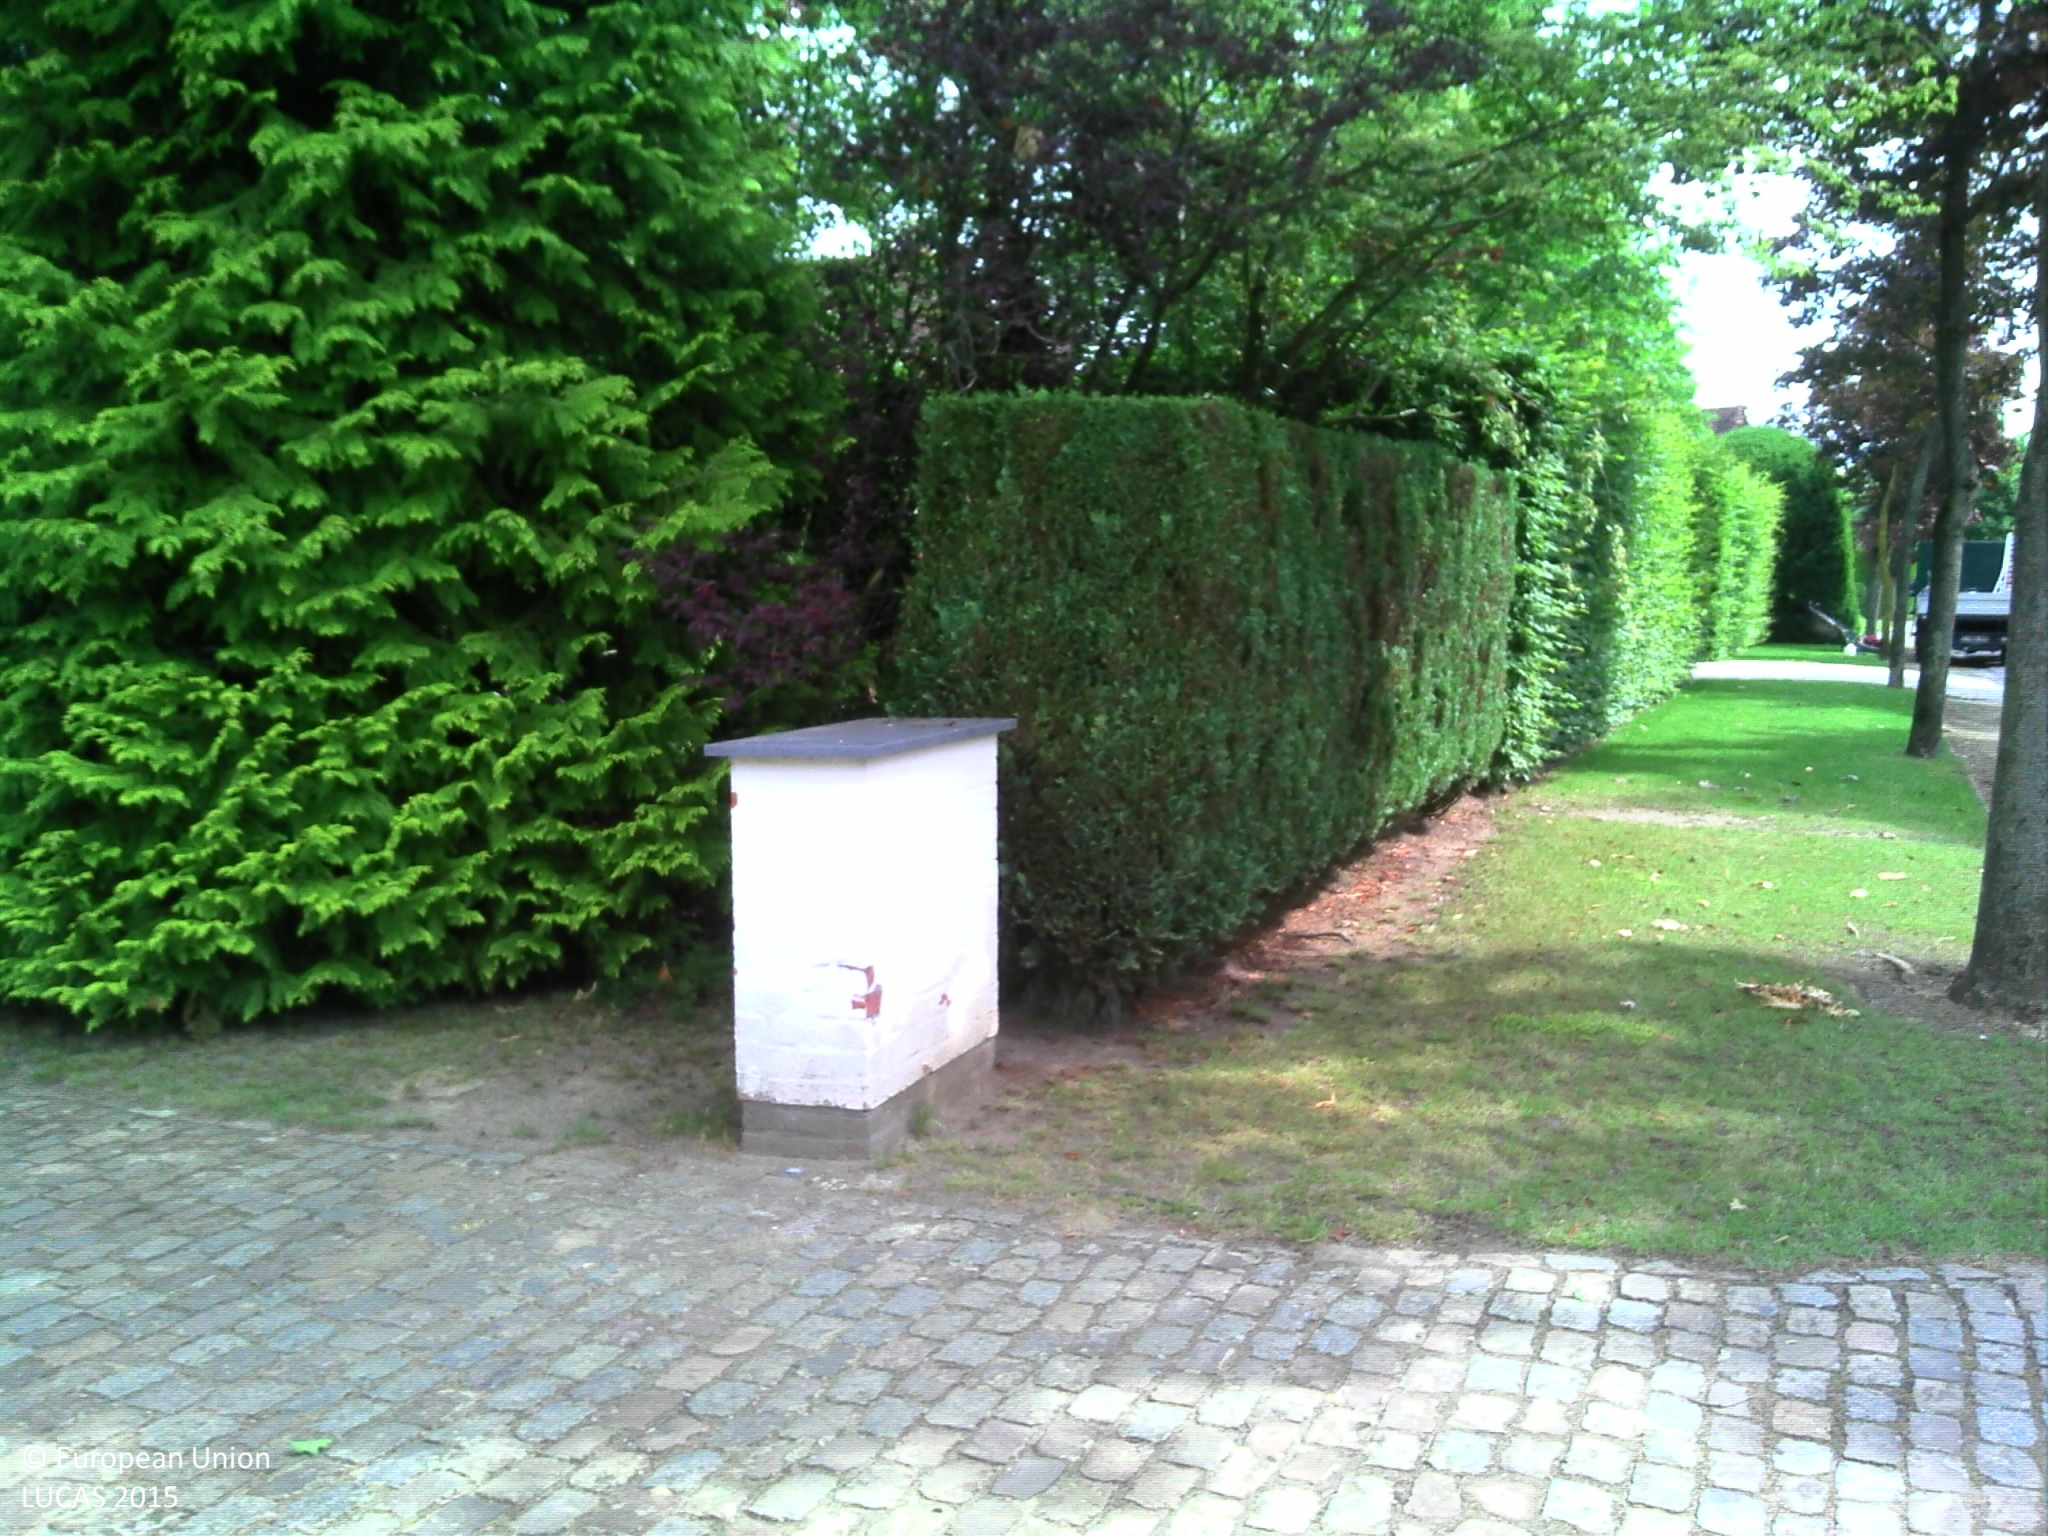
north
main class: Grassland
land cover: Grassland with sparse tree/shrub cover
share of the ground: > 75 %
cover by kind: herbaceous plants 95 %, broadleaved forest trees 5 %
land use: Residential
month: June
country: BE
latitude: 51.0009
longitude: 3.6802
